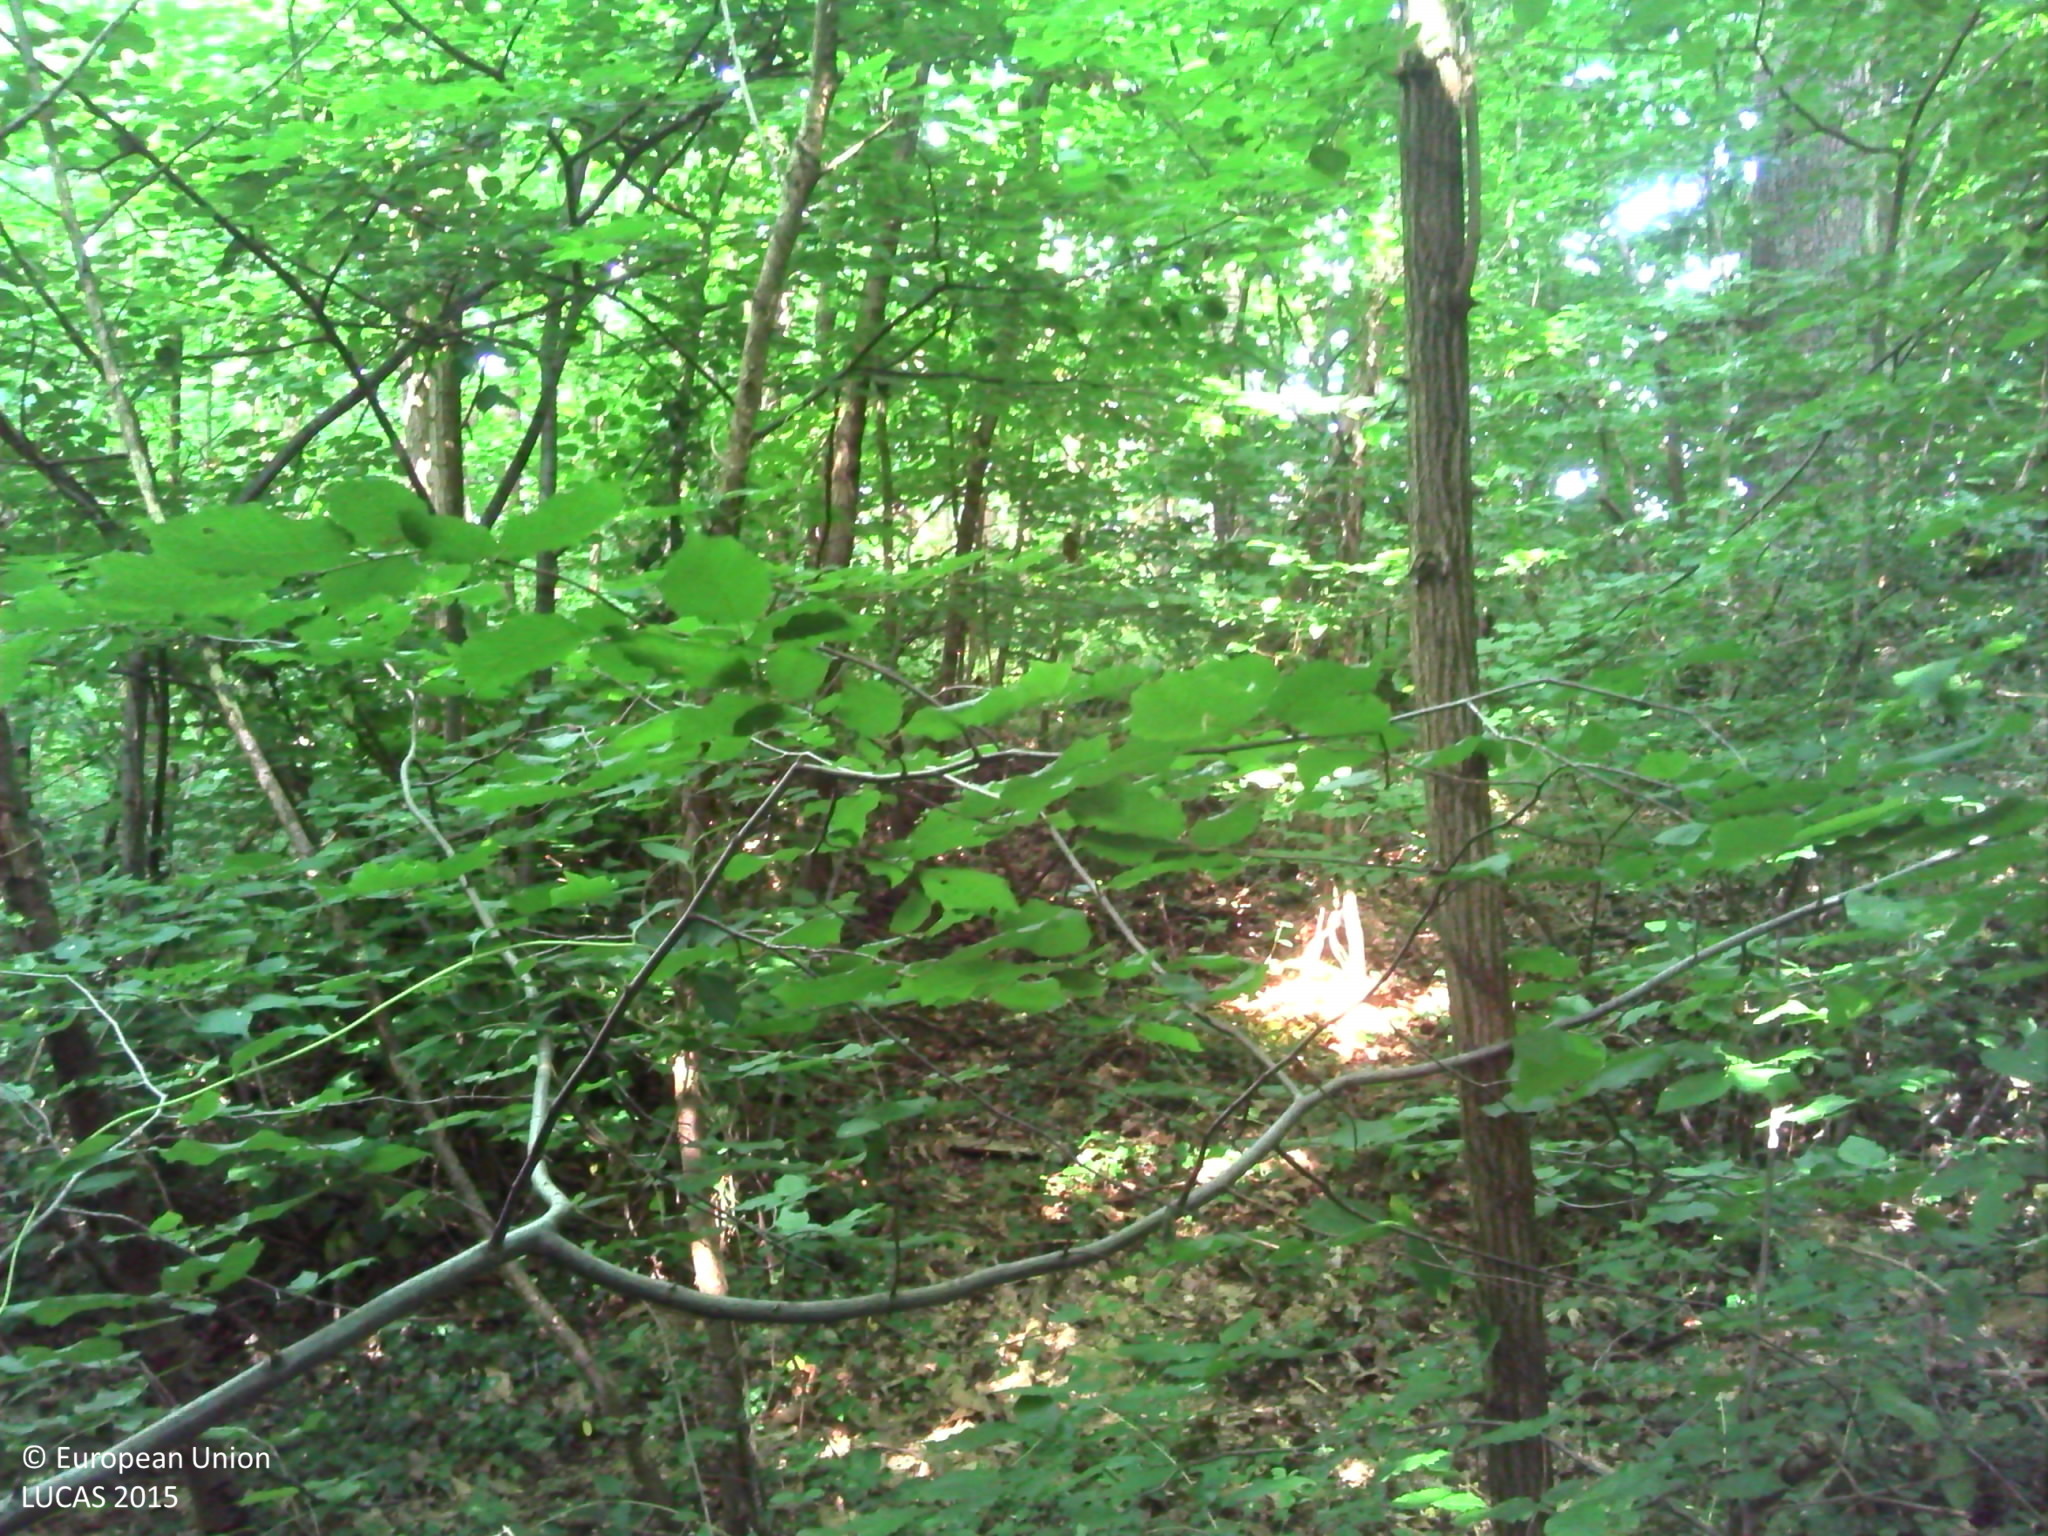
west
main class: Woodland
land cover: Broadleaved woodland
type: acidophilous oak and oak-birch forest
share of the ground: > 75 %
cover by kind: broadleaved forest trees 85 %, herbaceous plants 15 %
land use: Forestry
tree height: > 5 m
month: June
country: FR
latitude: 46.1004
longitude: 4.8414
